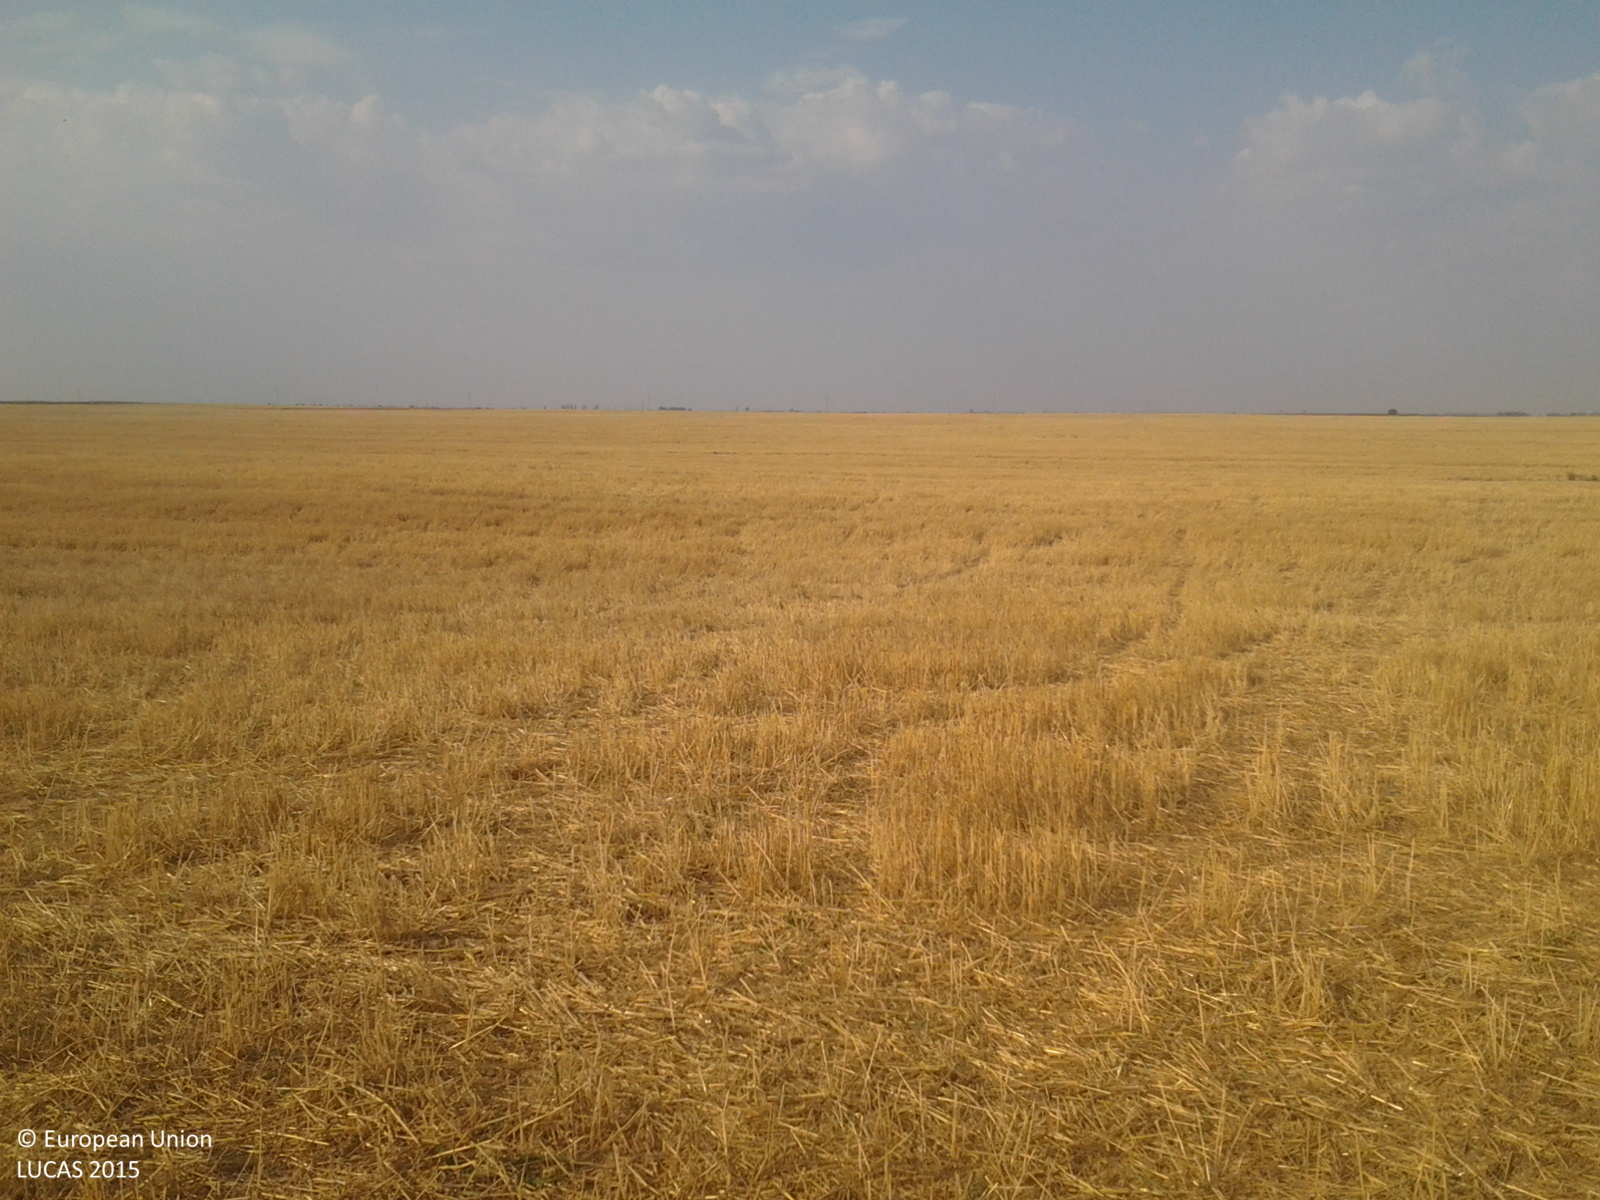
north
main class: Cropland
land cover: Common wheat
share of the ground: > 75 %
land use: Agriculture (excluding fallow land and kitchen gardens)
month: August
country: RO
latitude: 43.9471
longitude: 23.0118
